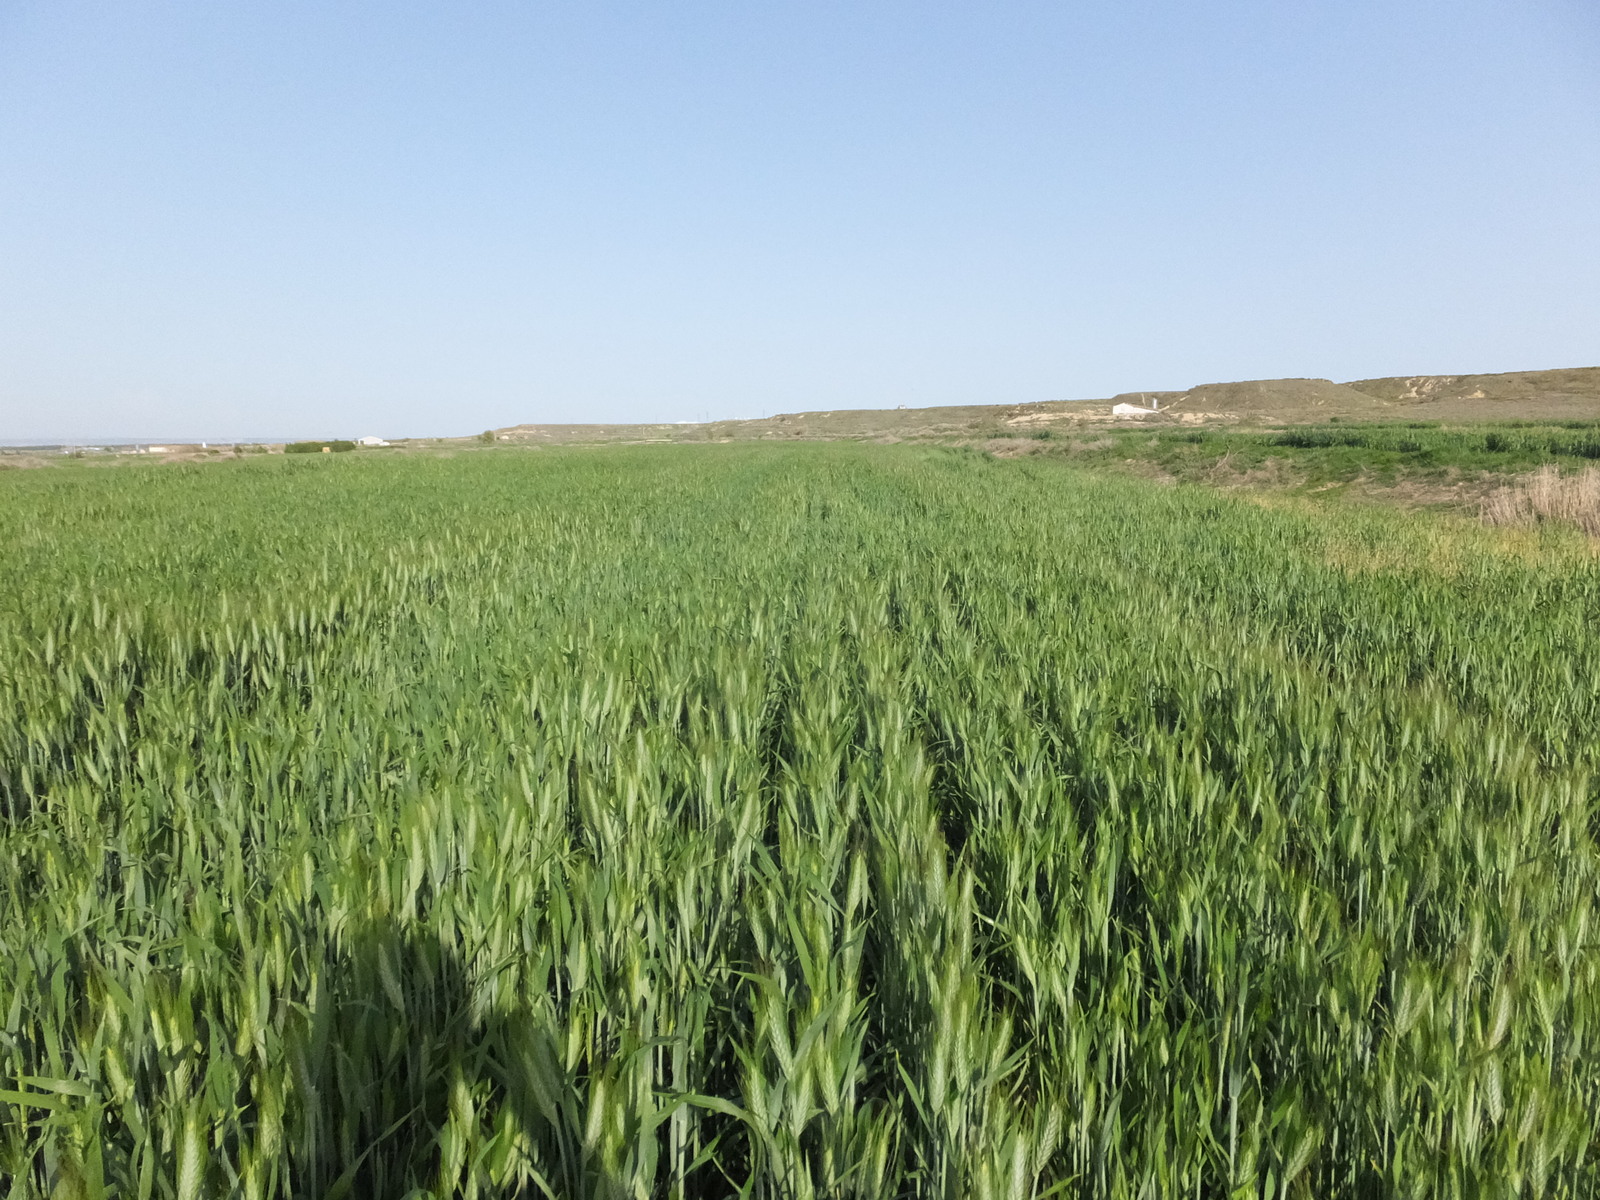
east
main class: Cropland
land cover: Durum wheat
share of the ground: > 75 %
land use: Agriculture (excluding fallow land and kitchen gardens)
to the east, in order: Durum wheat; Grass margins; Durum wheat
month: April
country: ES
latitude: 41.7763
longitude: -0.3535
